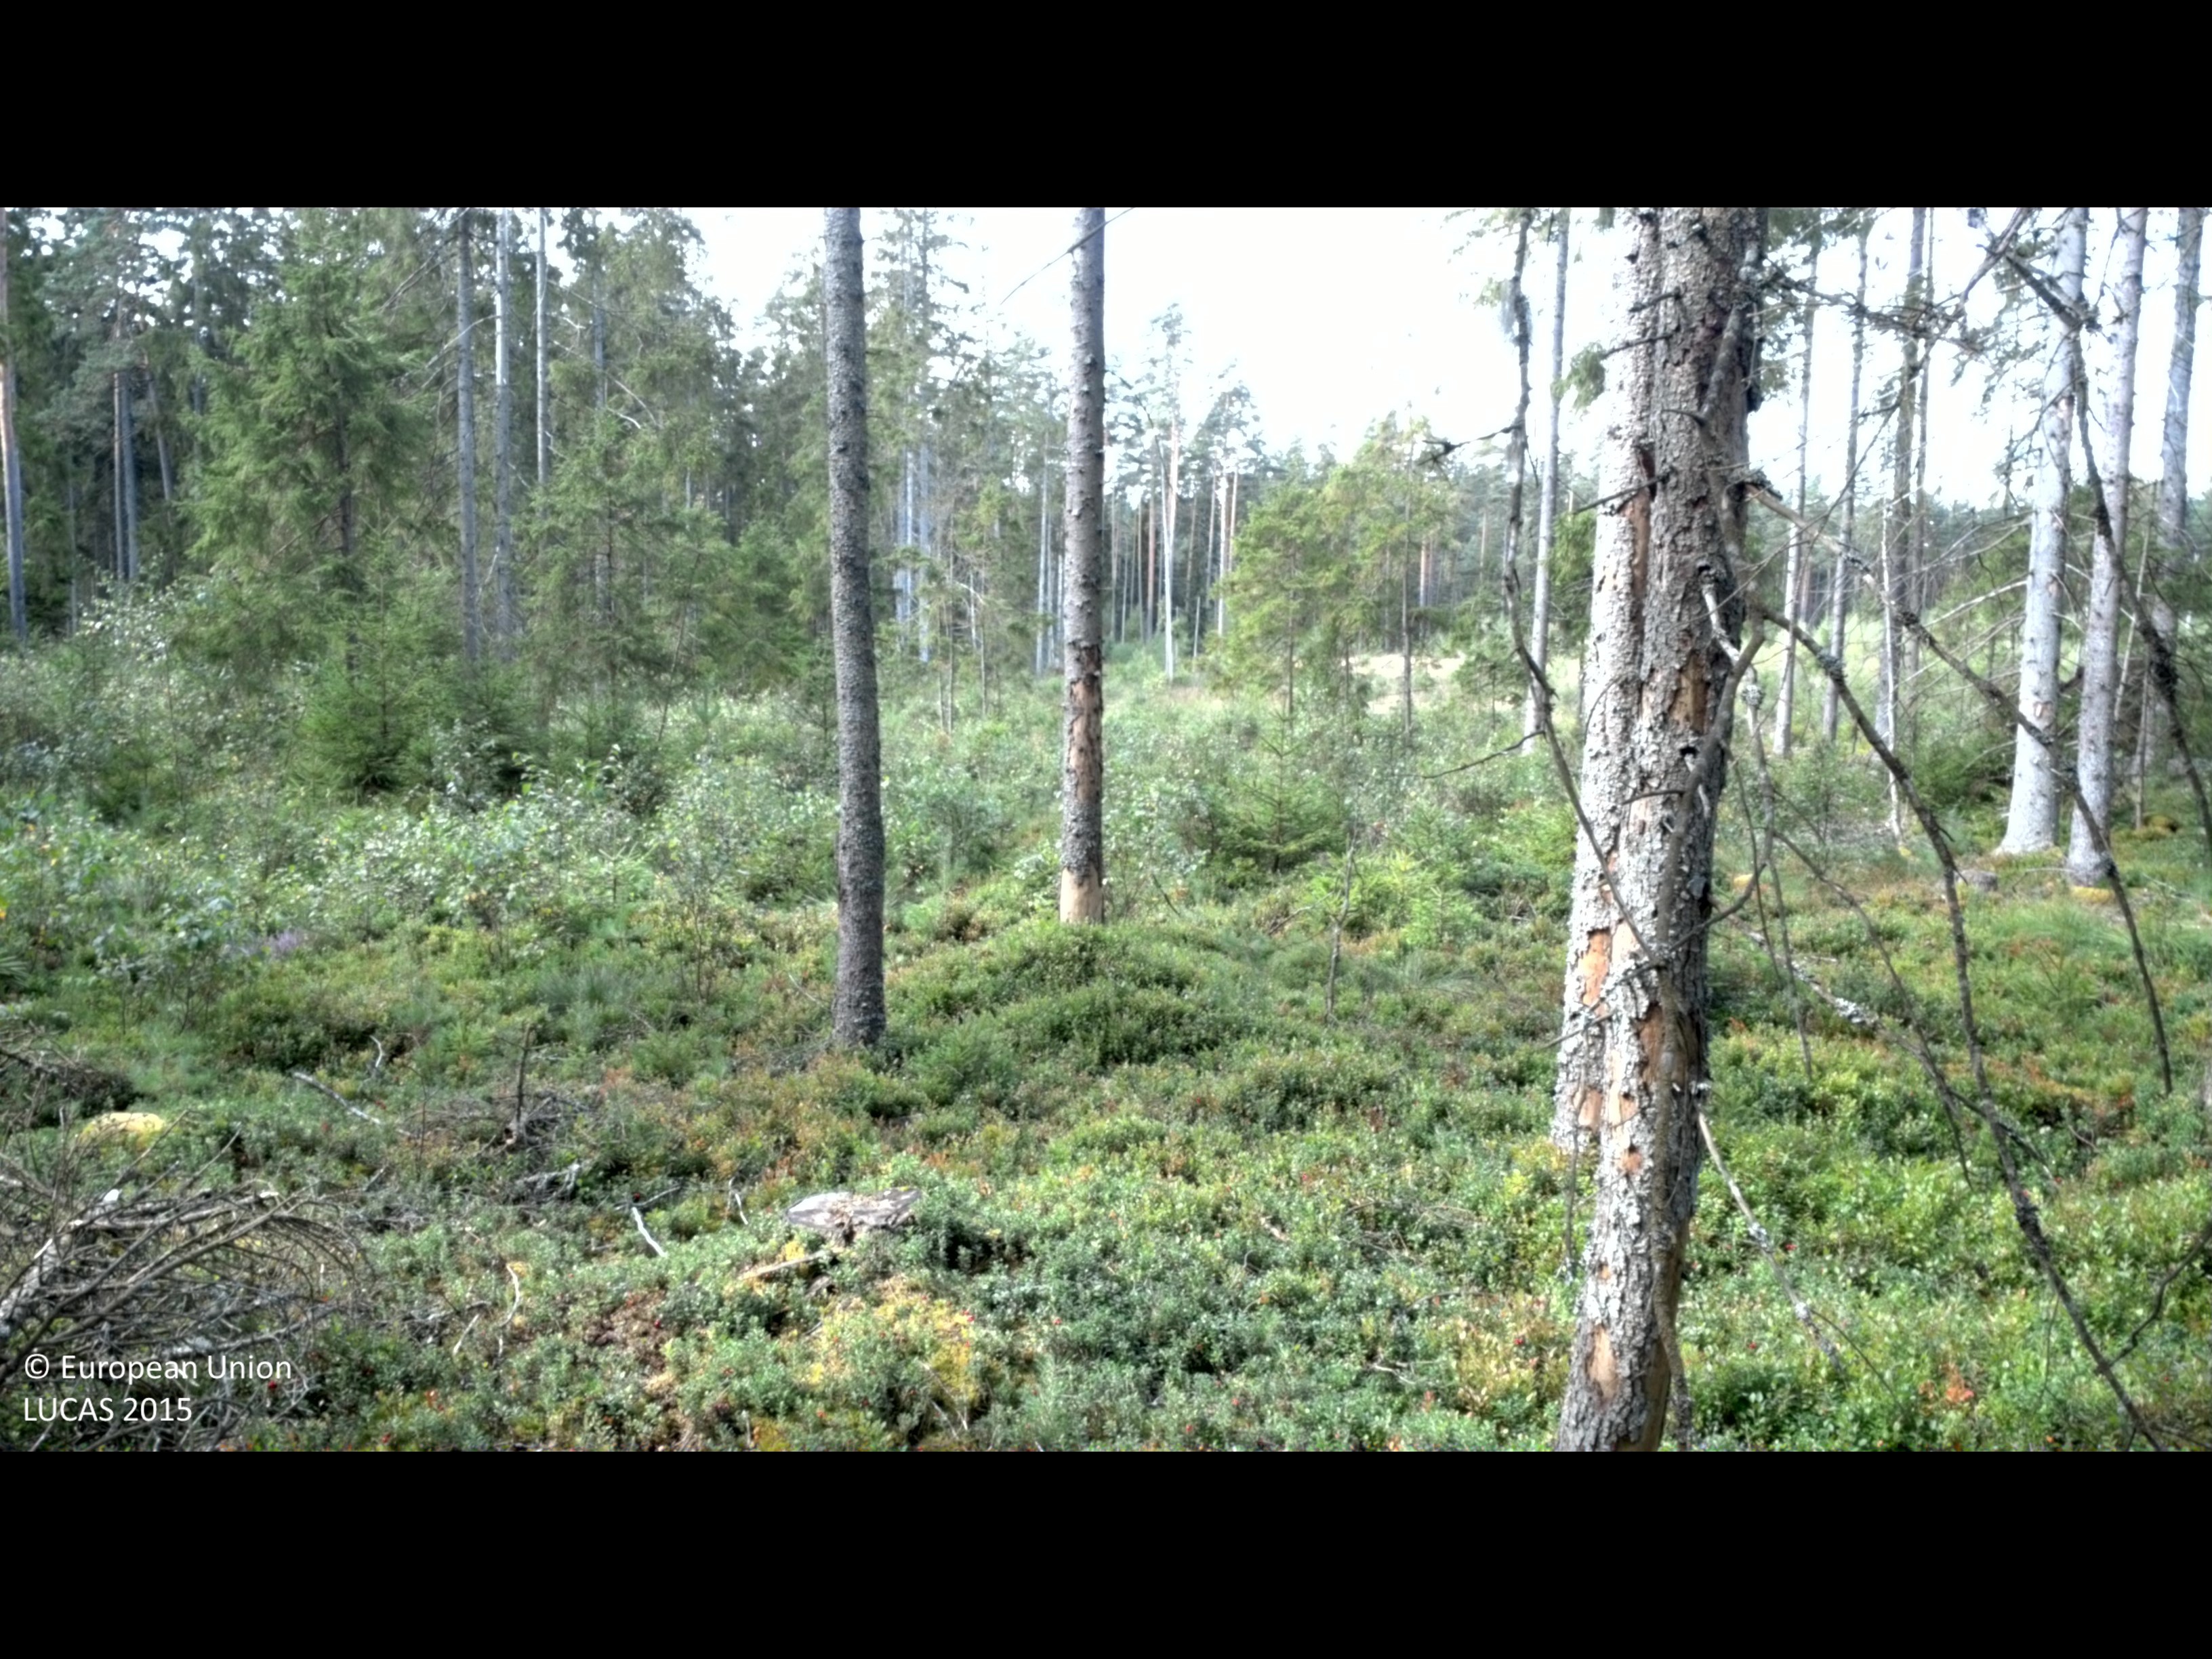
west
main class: Woodland
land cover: Spruce dominated coniferous woodland
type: boreal forest
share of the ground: 50 - 75 %
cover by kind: coniferous forest trees 70 %, shrubs 30 %
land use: Forestry
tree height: > 5 m
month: August
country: SE
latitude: 57.1751
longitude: 13.8169
